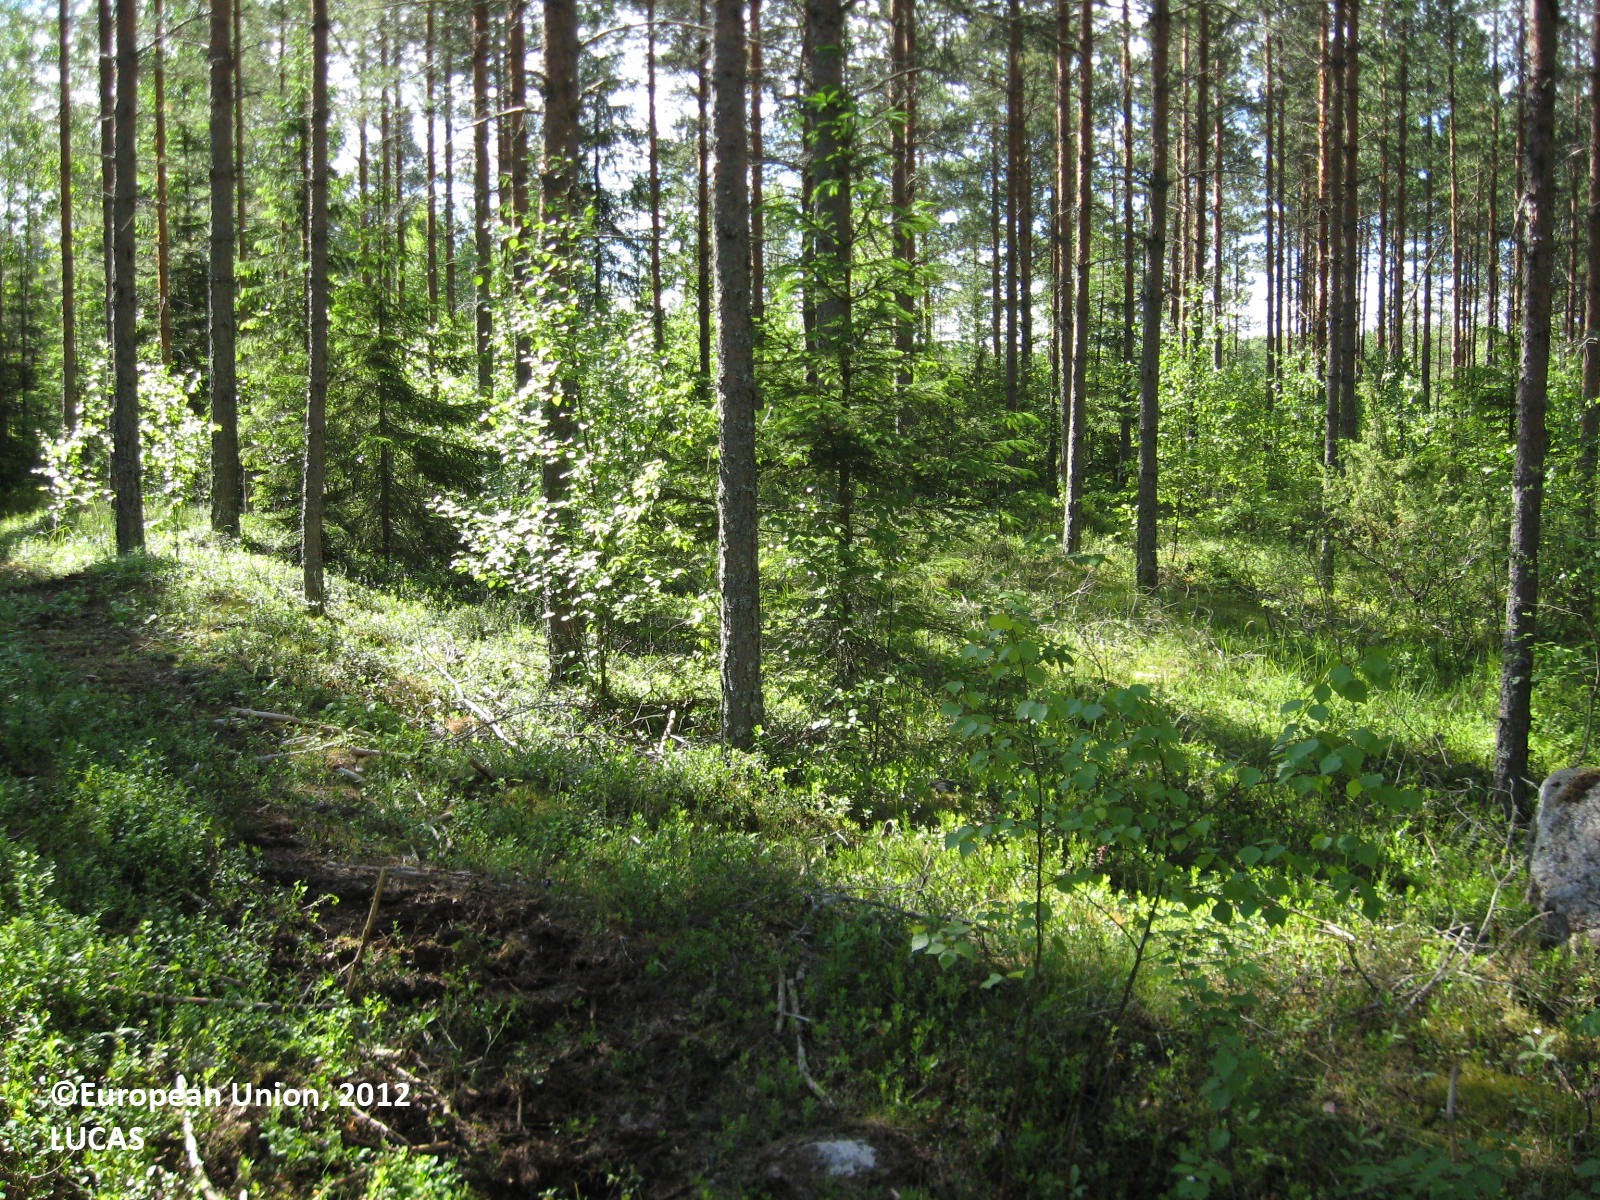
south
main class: Woodland
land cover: Pine dominated coniferous woodland
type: boreal forest
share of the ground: > 75 %
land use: Forestry
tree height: > 5 m
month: June
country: FI
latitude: 62.8317
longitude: 21.6839
